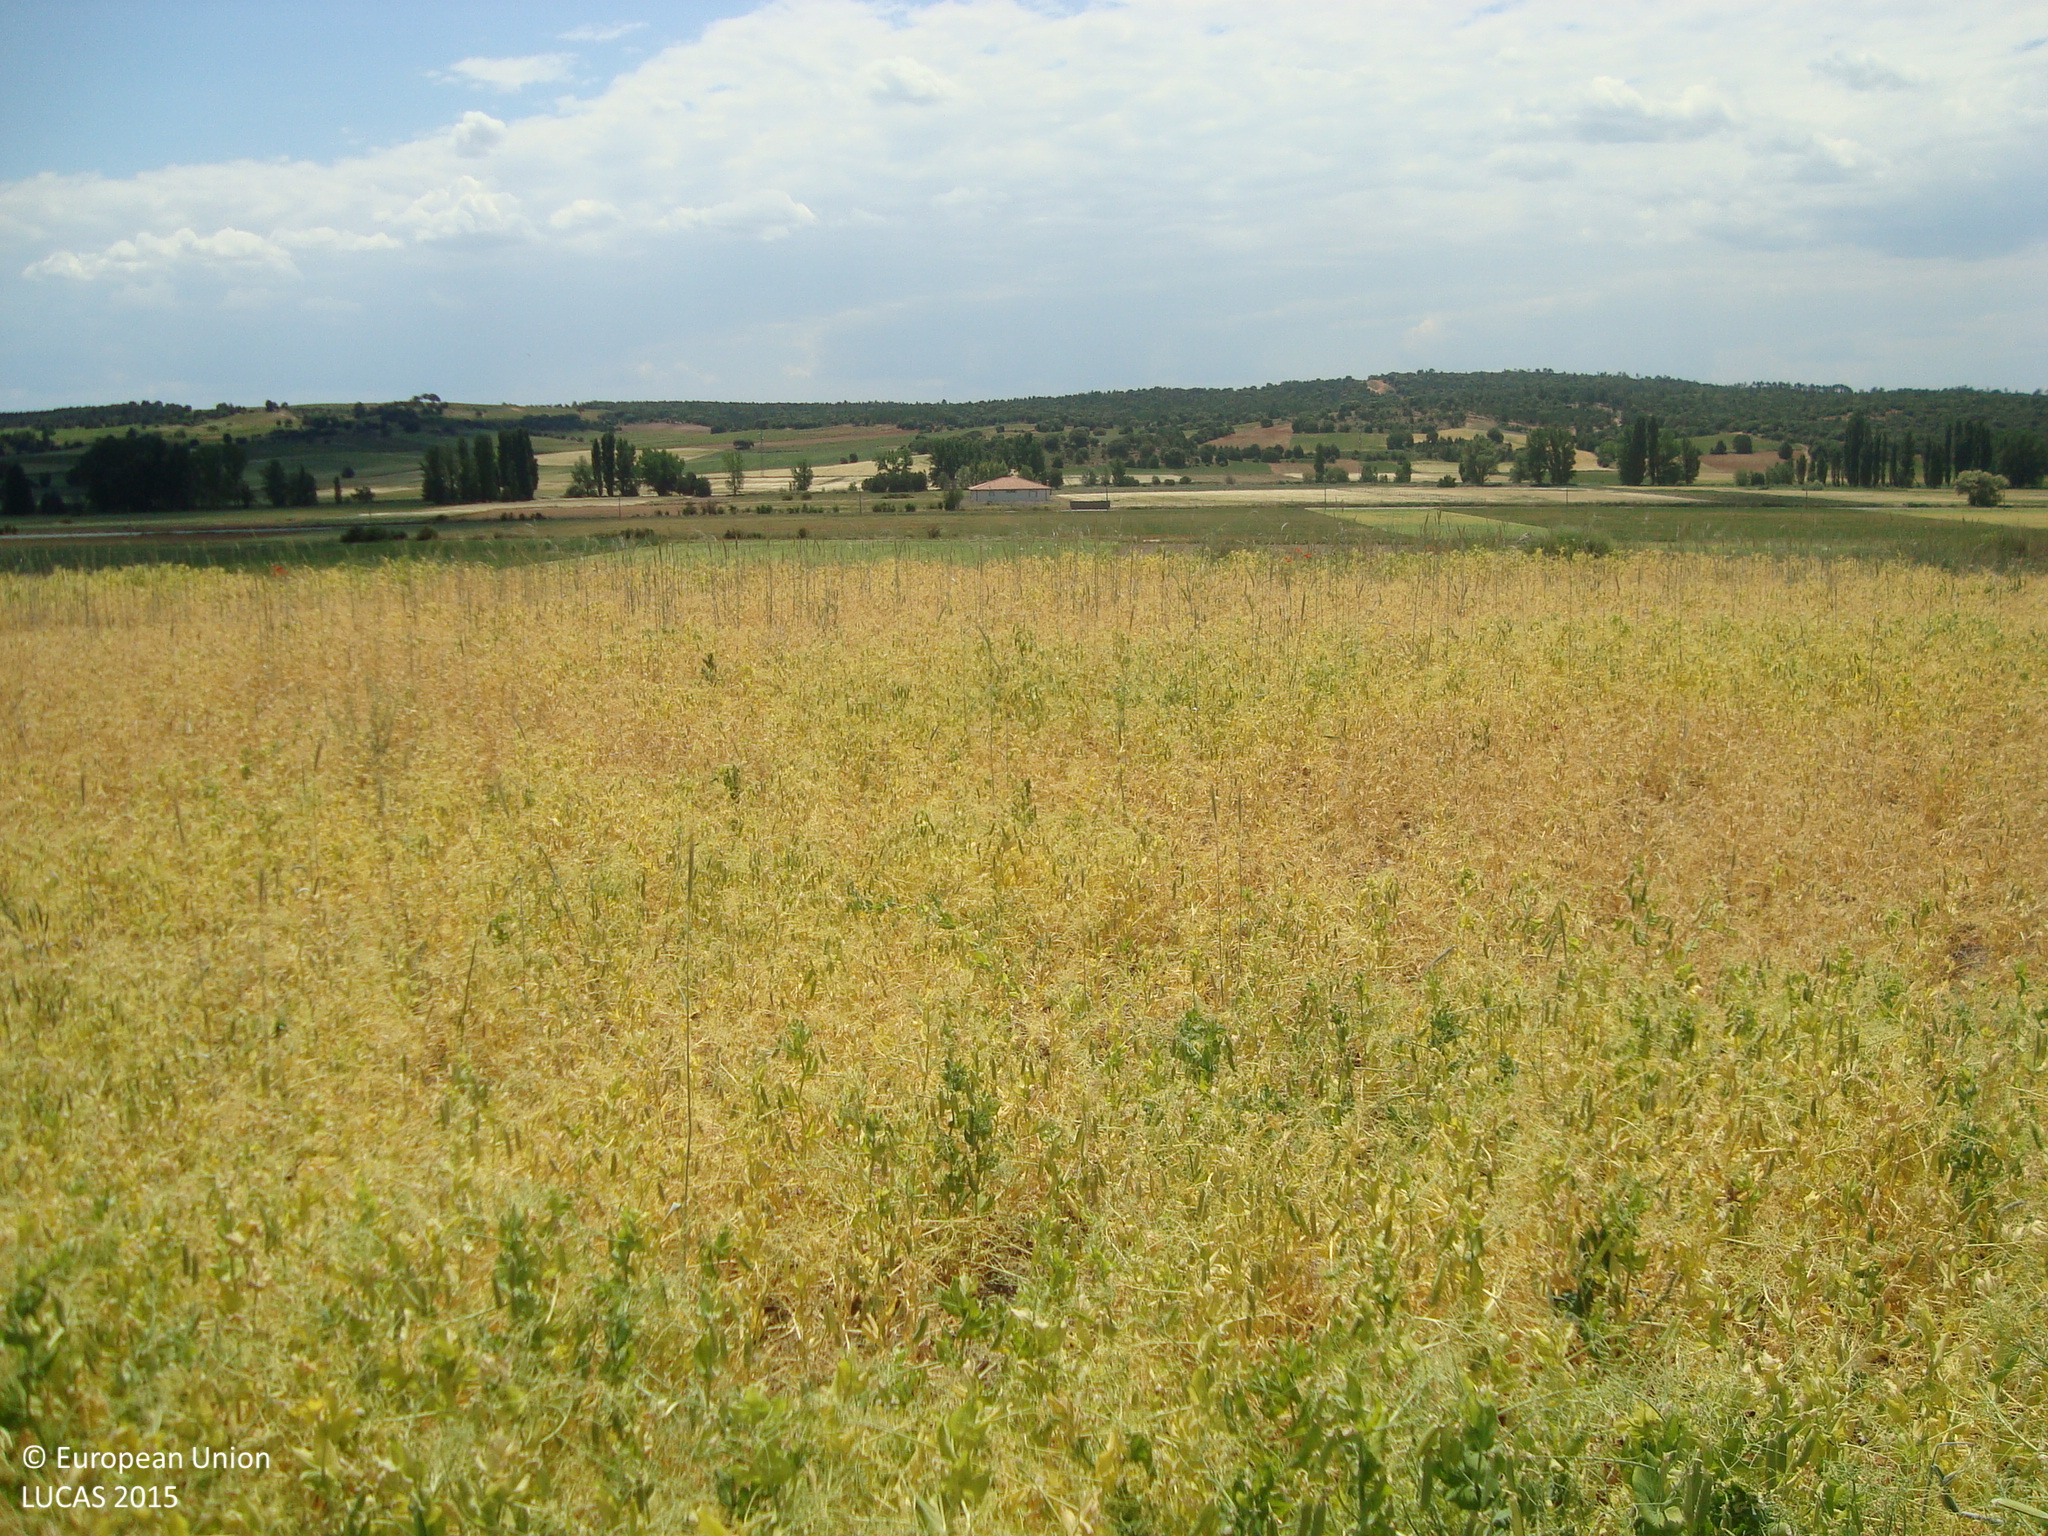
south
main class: Cropland
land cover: Dry pulses
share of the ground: > 75 %
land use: Agriculture (excluding fallow land and kitchen gardens)
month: June
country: ES
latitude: 41.6962
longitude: -3.5935
